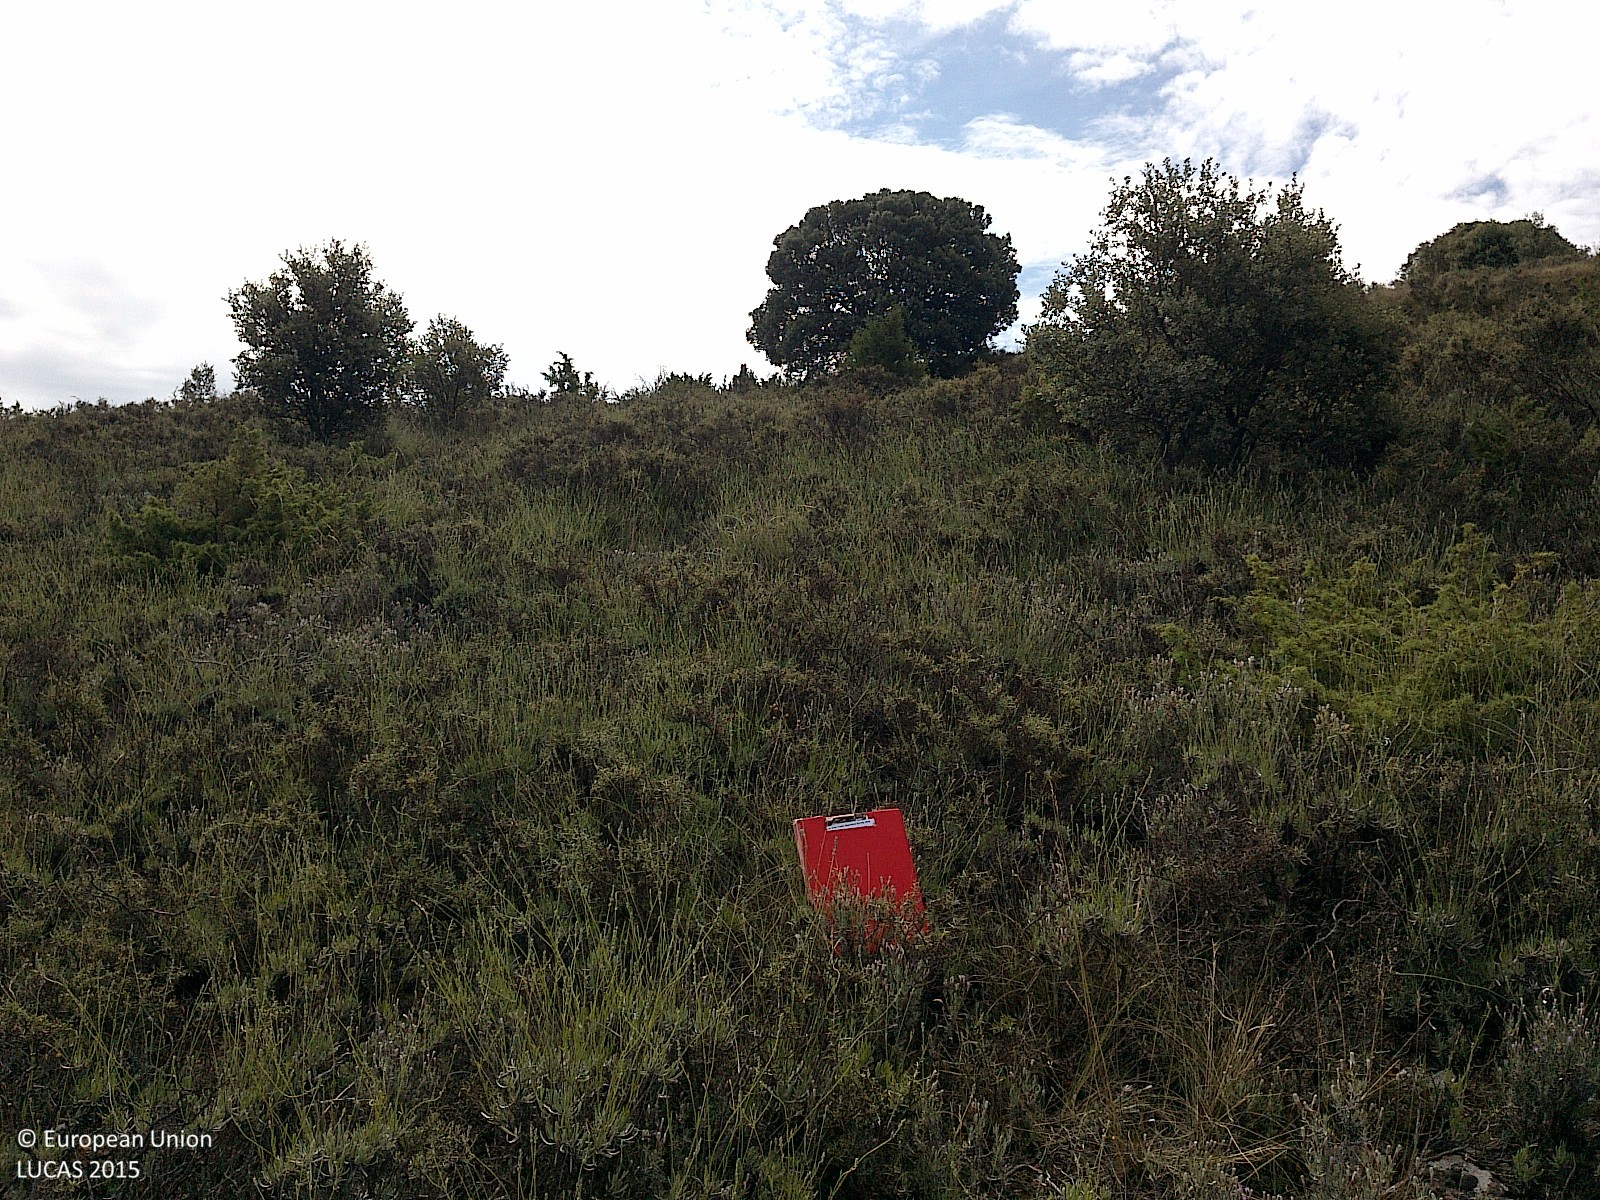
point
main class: Shrubland
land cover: Shrubland with sparse tree cover
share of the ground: > 75 %
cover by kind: shrubs 85 %, herbaceous plants 10 %, broadleaved forest trees 5 %
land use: Semi-natural and natural areas not in use
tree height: < 5 m
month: July
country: ES
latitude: 41.5416
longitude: -1.9574
